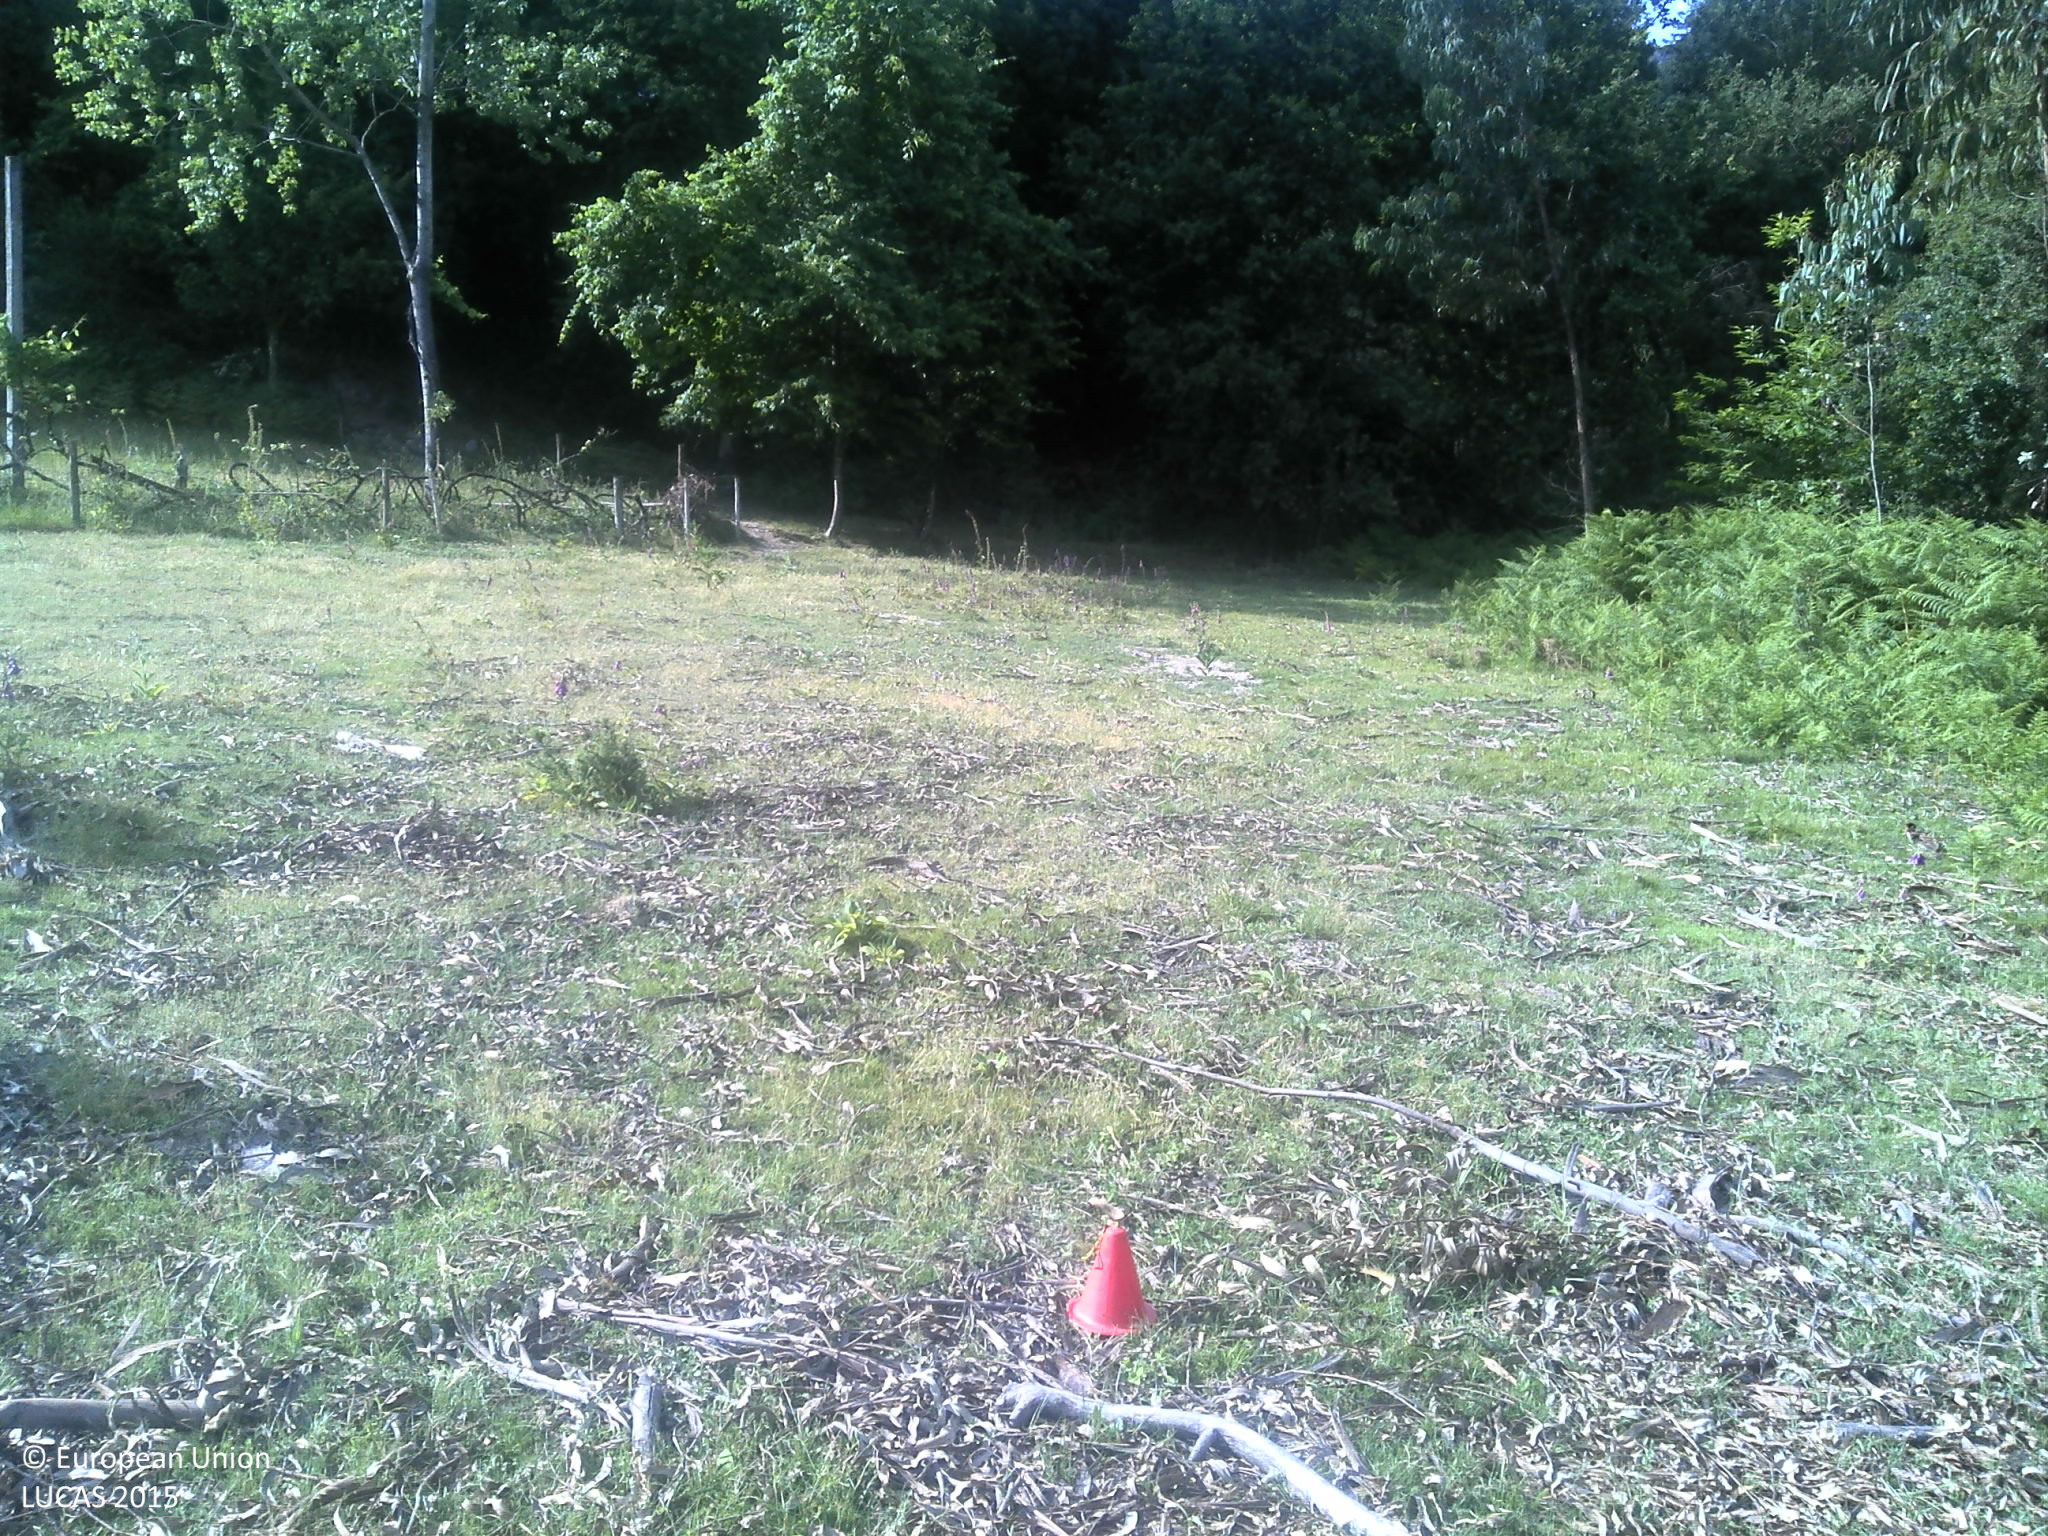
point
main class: Grassland
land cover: Grassland without tree/shrub cover
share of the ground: 50 - 75 %
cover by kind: herbaceous plants 85 %, unconsolidated bare surface 10 %, shrubs 5 %
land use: Agriculture (excluding fallow land and kitchen gardens)
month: June
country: PT
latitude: 41.5840
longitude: -8.1756
